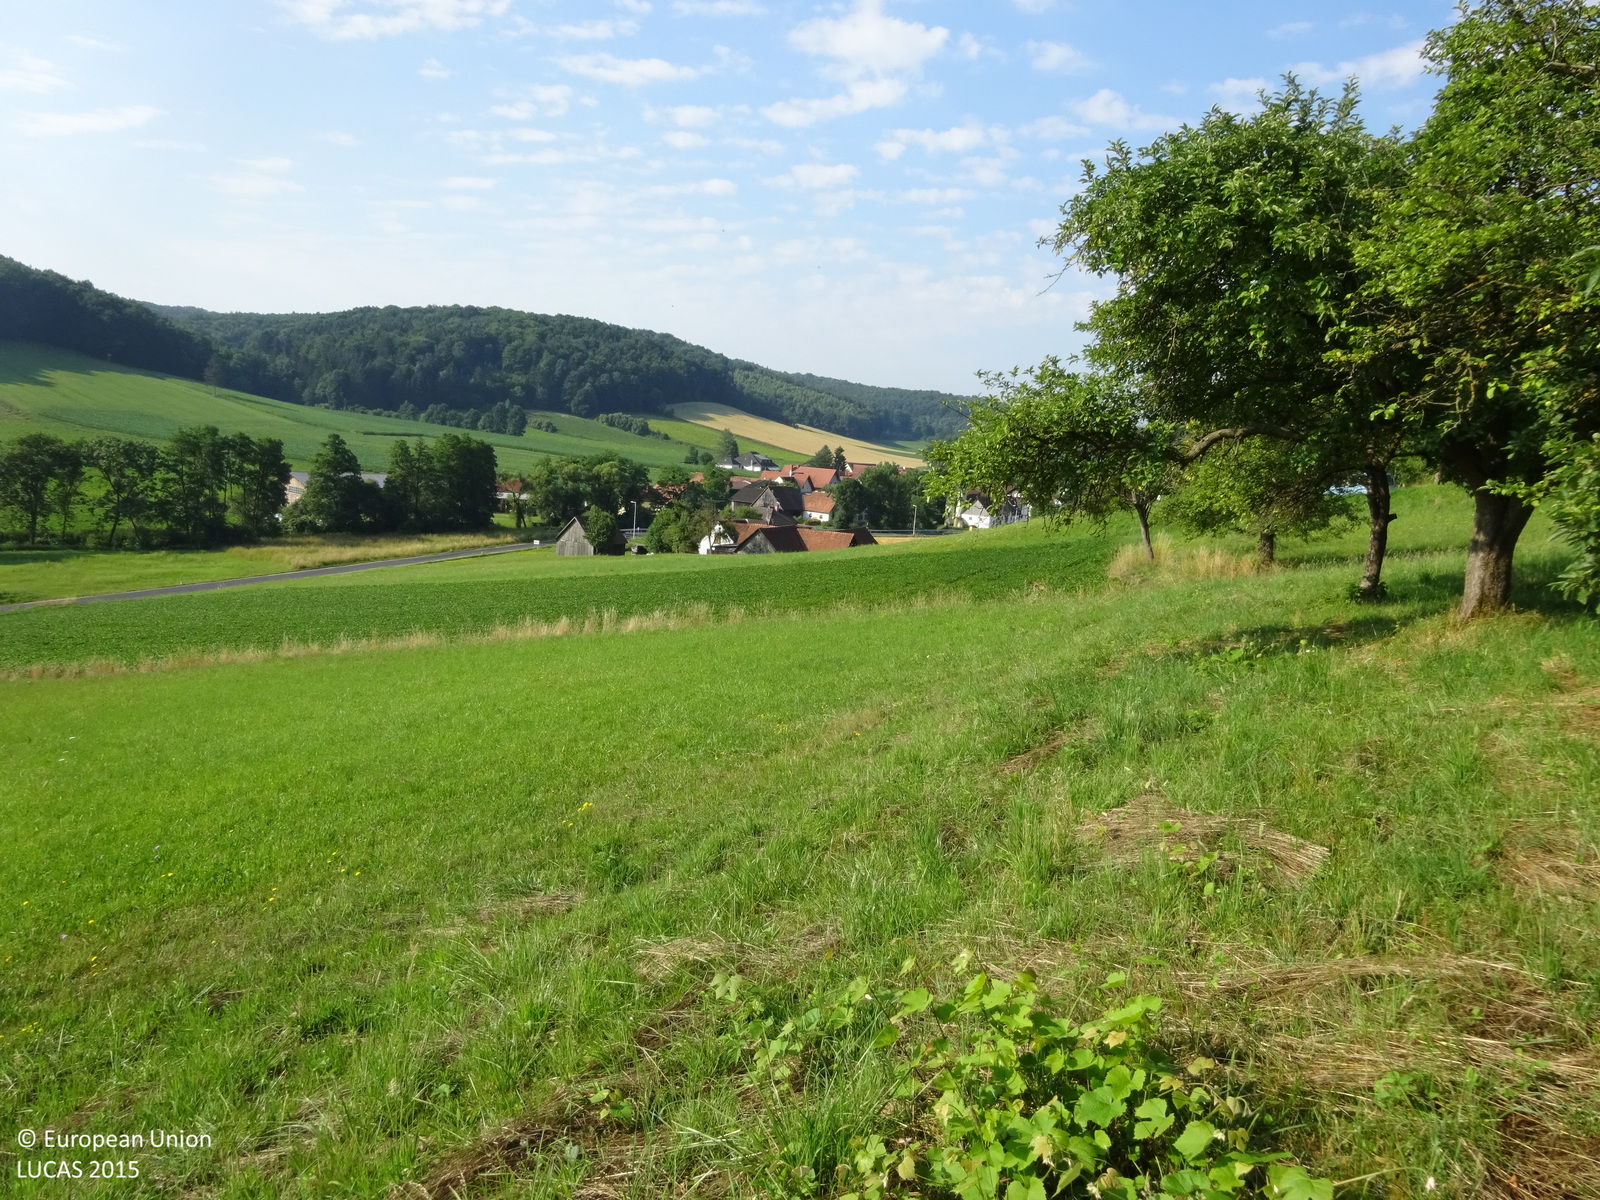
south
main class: Cropland
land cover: Apple fruit
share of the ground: 25 - 50 %
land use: Kitchen garden
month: July
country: AT
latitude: 46.9215
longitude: 16.0285
